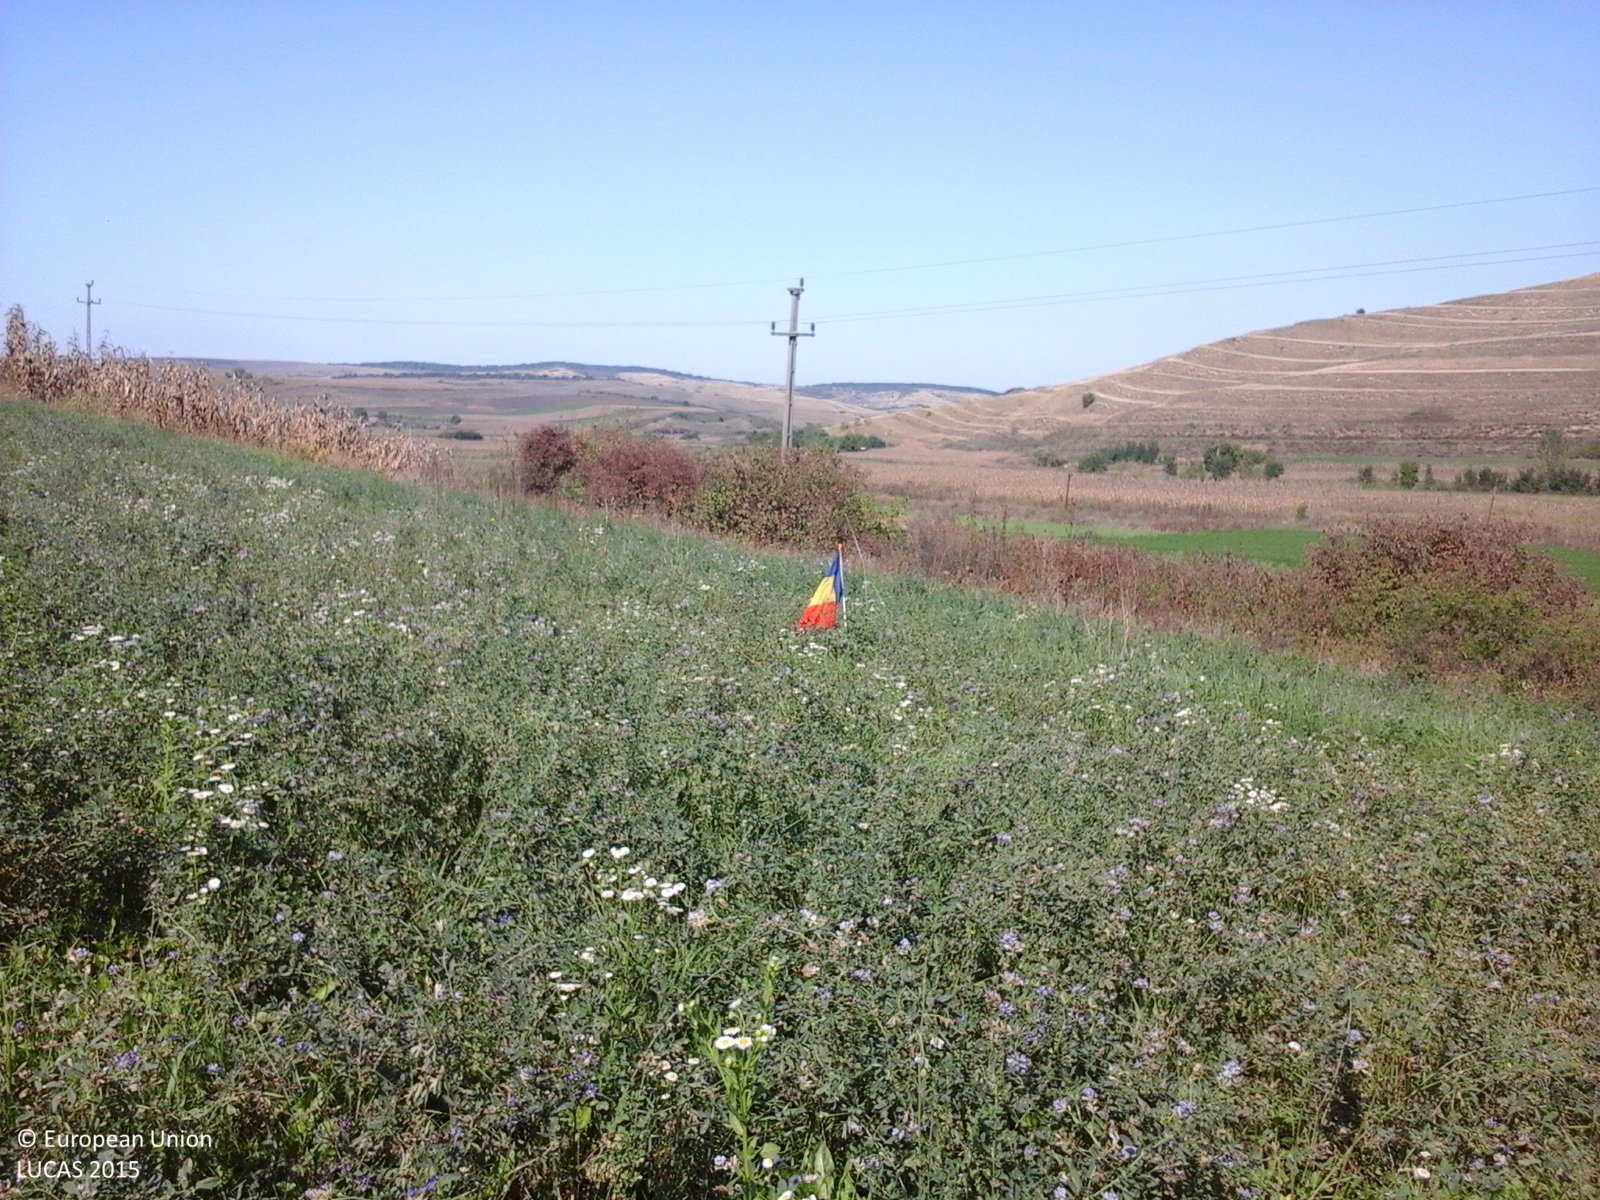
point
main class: Cropland
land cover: Other leguminous and mixtures for fodder
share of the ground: > 75 %
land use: Agriculture (excluding fallow land and kitchen gardens)
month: October
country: RO
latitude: 46.1068
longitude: 23.9552
